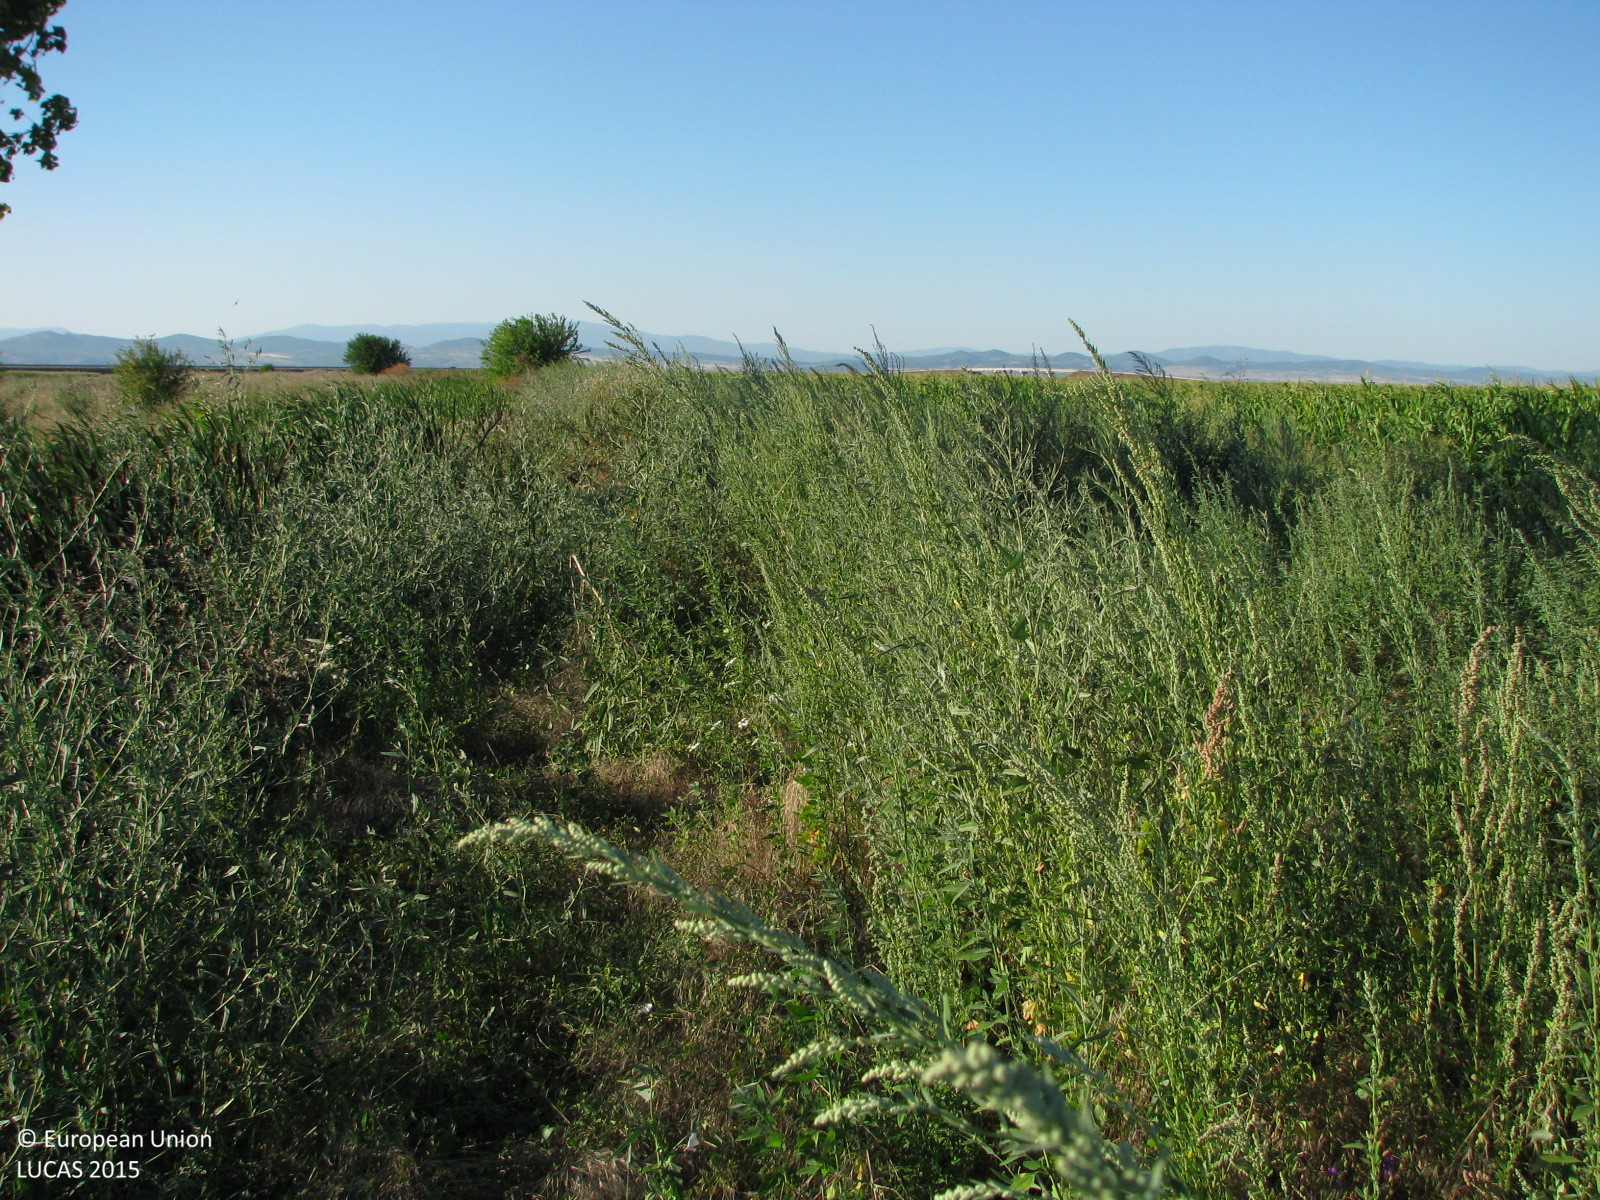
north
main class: Cropland
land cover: Maize
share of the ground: > 75 %
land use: Agriculture (excluding fallow land and kitchen gardens)
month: July
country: BG
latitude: 42.4254
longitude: 25.9645
